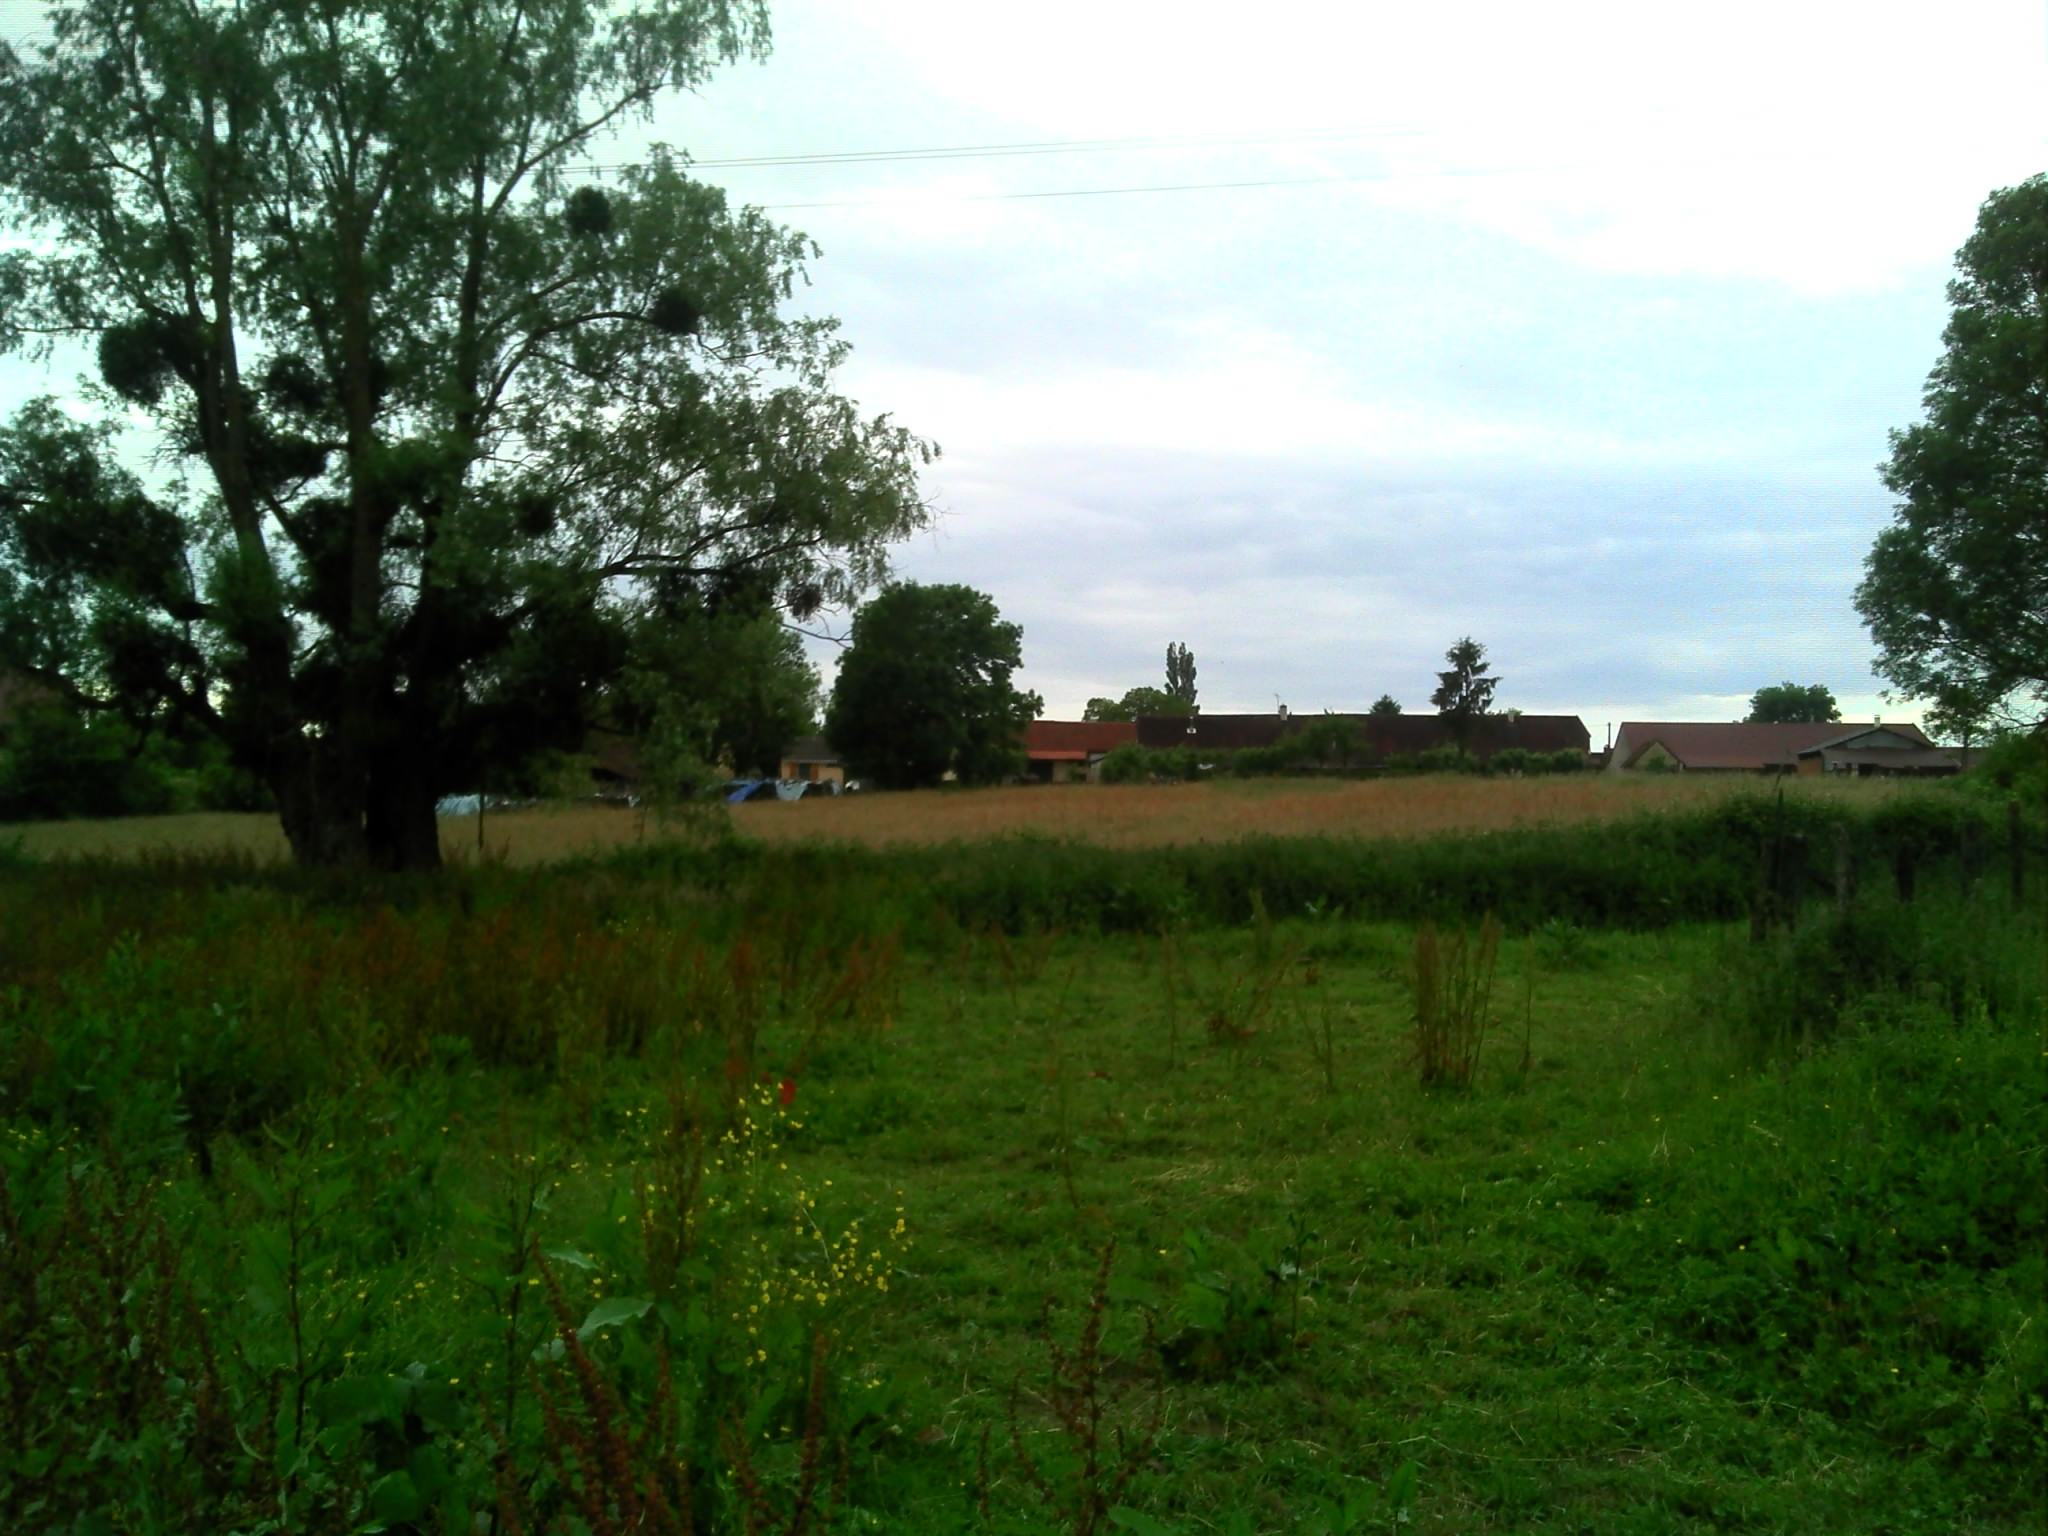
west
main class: Grassland
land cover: Grassland with sparse tree/shrub cover
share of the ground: > 75 %
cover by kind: herbaceous plants 95 %, broadleaved forest trees 5 %
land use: Agriculture (excluding fallow land and kitchen gardens)
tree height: < 5 m
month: May
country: FR
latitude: 46.5948
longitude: 5.3947
